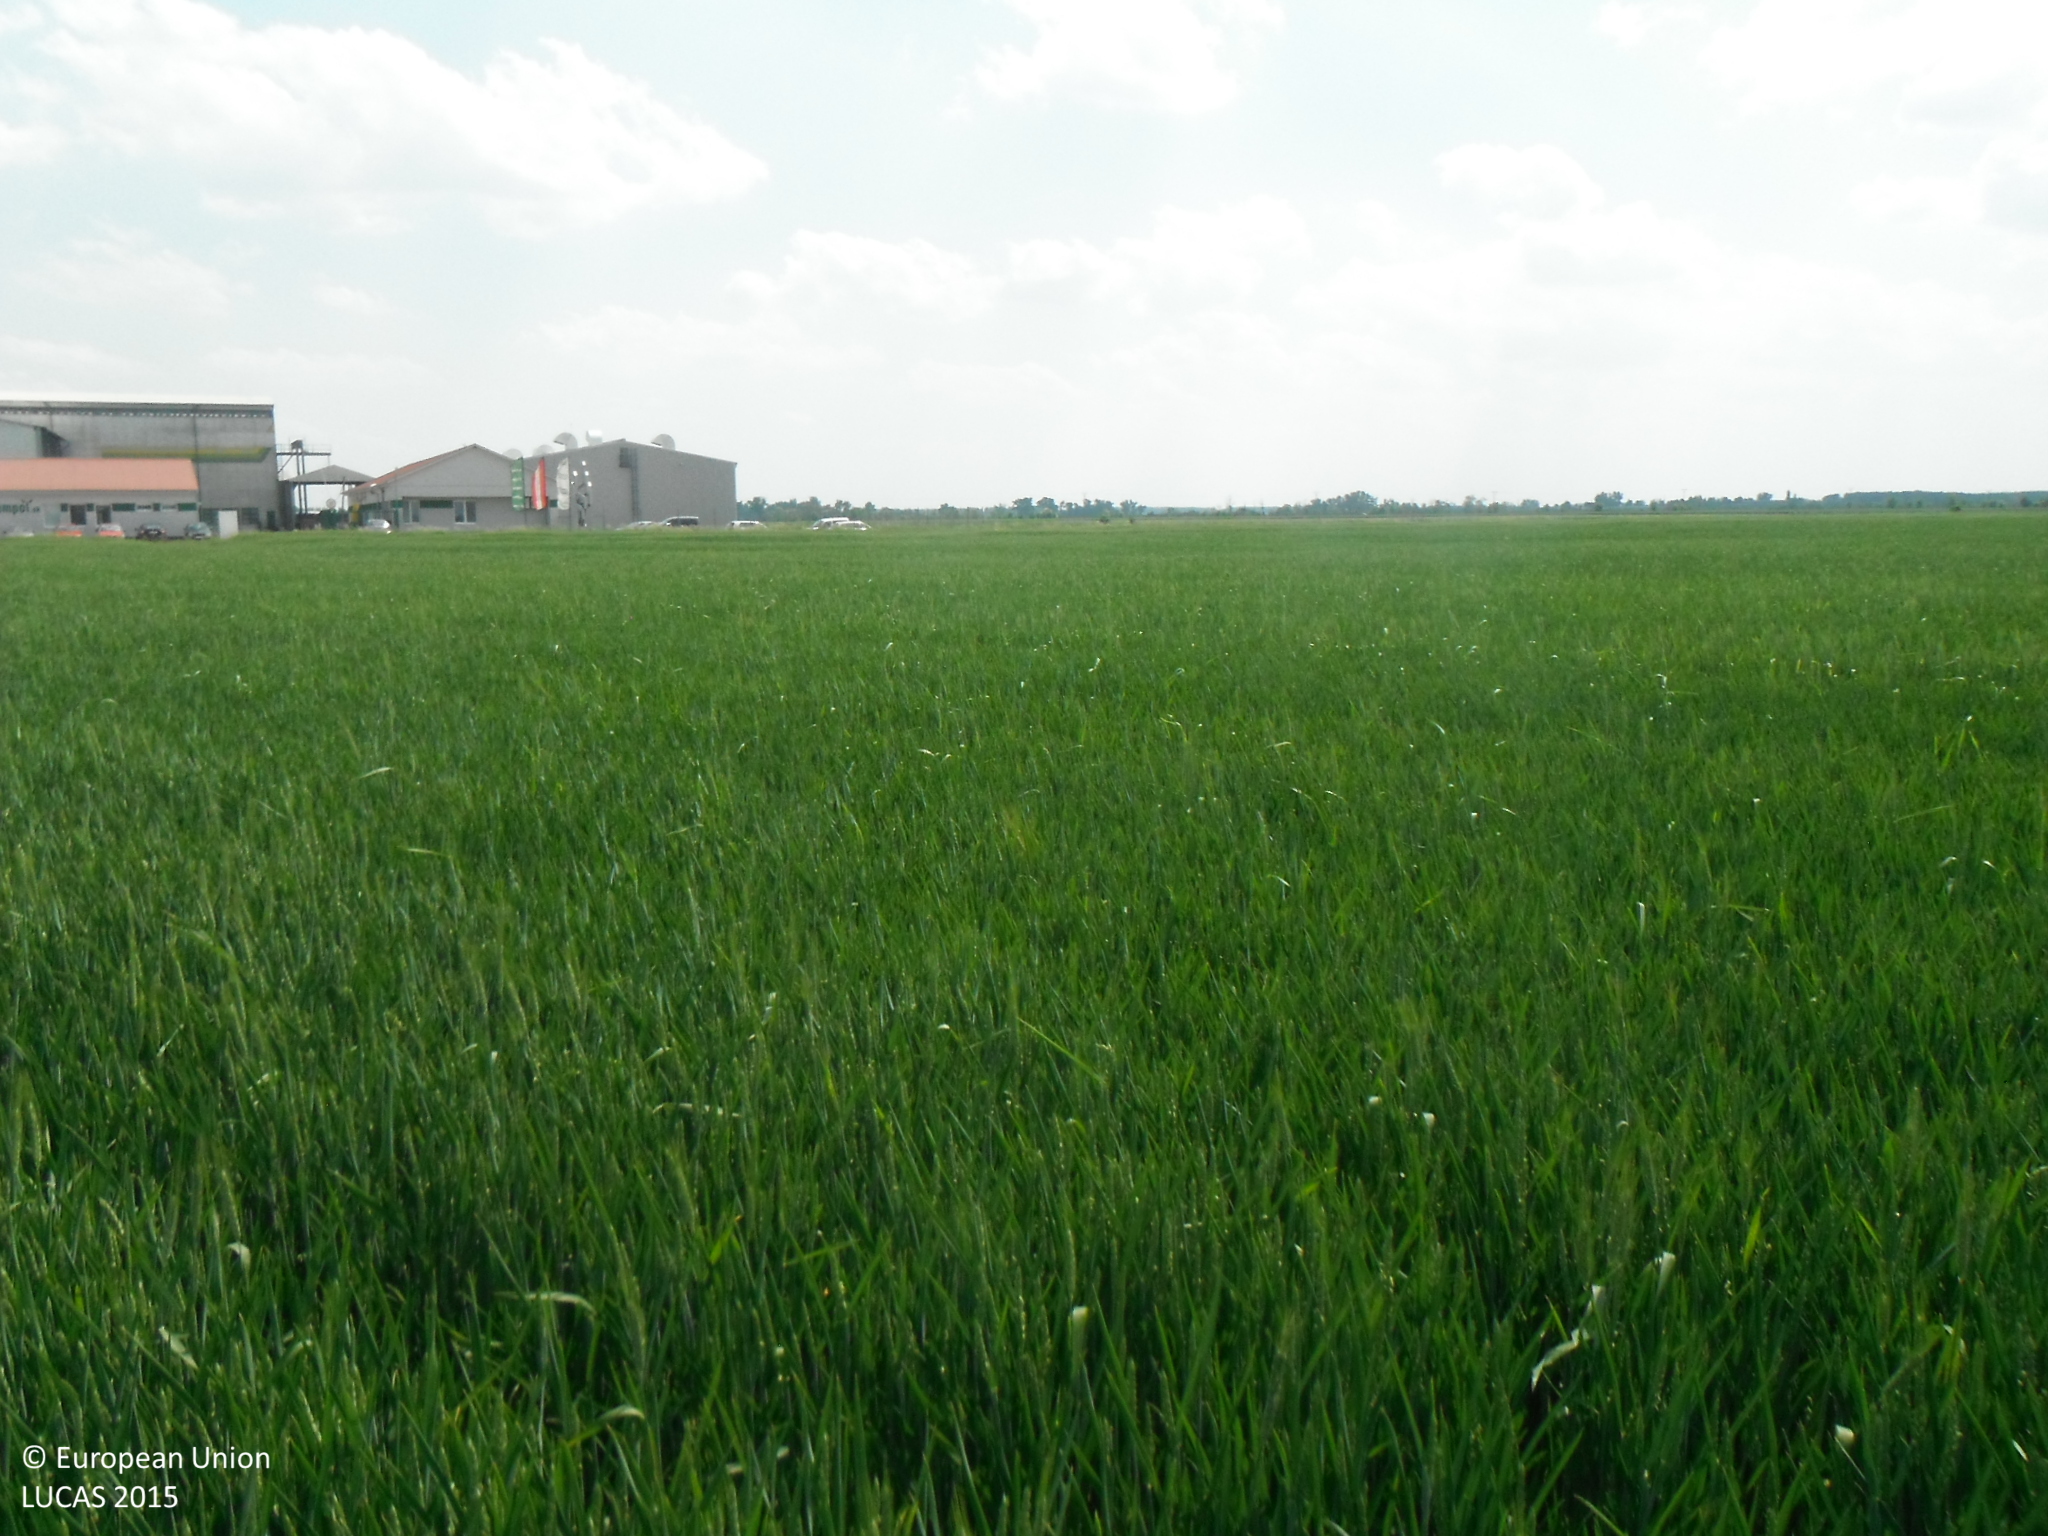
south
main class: Cropland
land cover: Common wheat
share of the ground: > 75 %
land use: Agriculture (excluding fallow land and kitchen gardens)
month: May
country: SK
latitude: 47.9514
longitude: 17.7367
